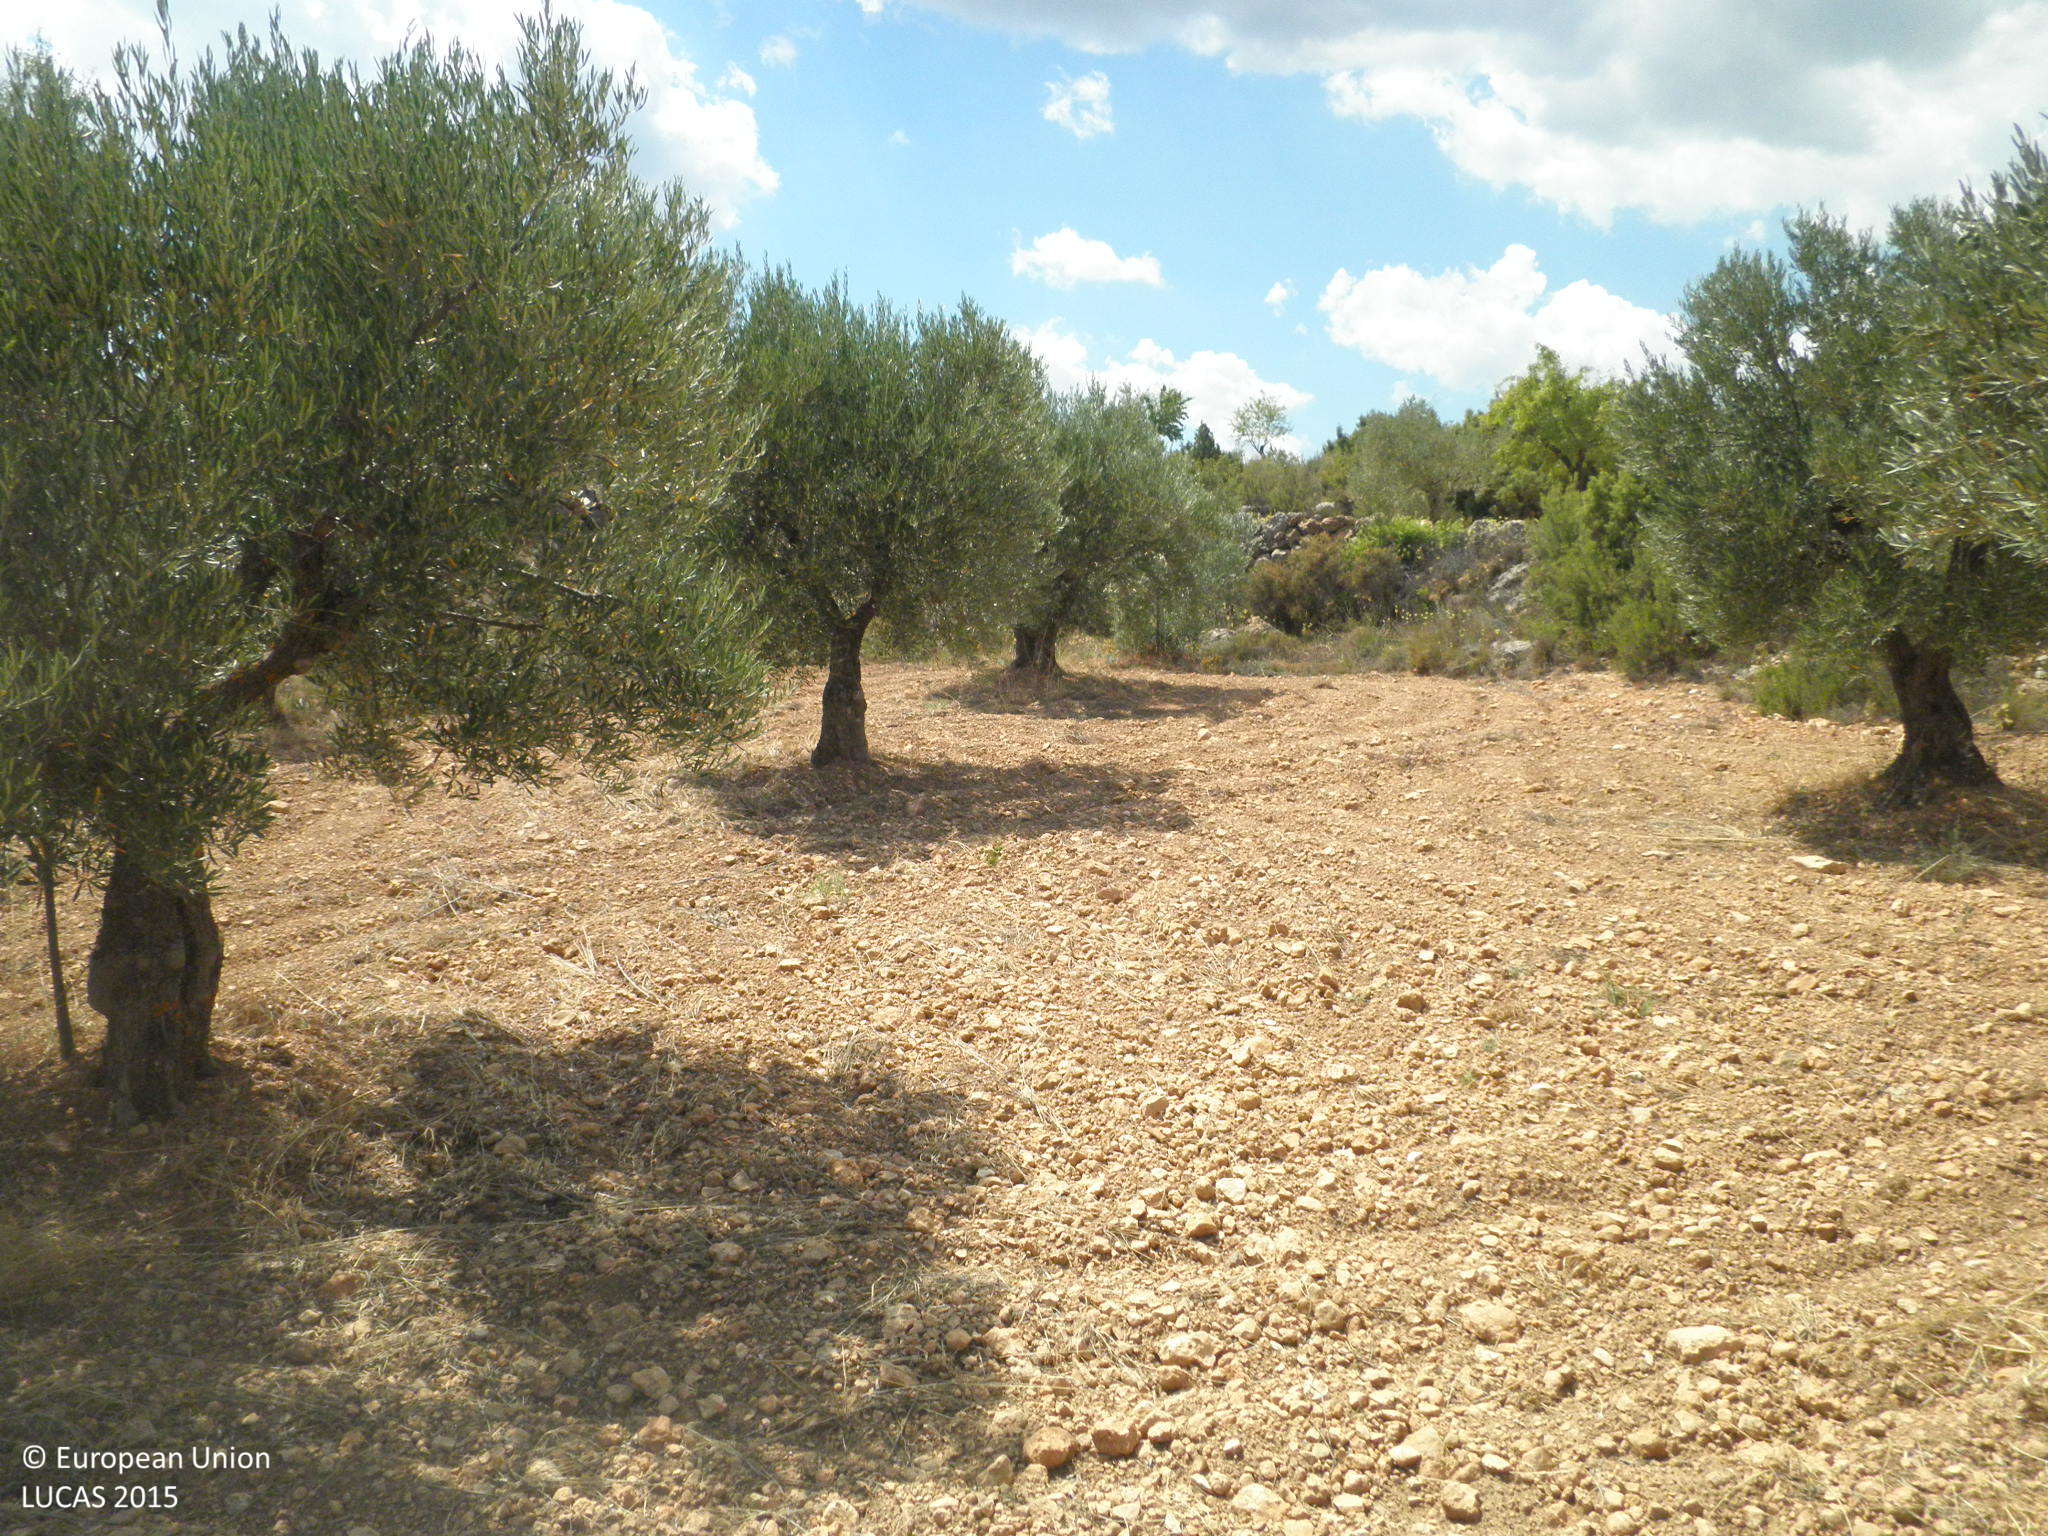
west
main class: Cropland
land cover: Olive groves
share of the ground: 10 - 25 %
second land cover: Other bare soil
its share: > 75 %
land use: Agriculture (excluding fallow land and kitchen gardens)
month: July
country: ES
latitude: 39.6675
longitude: -1.6054
